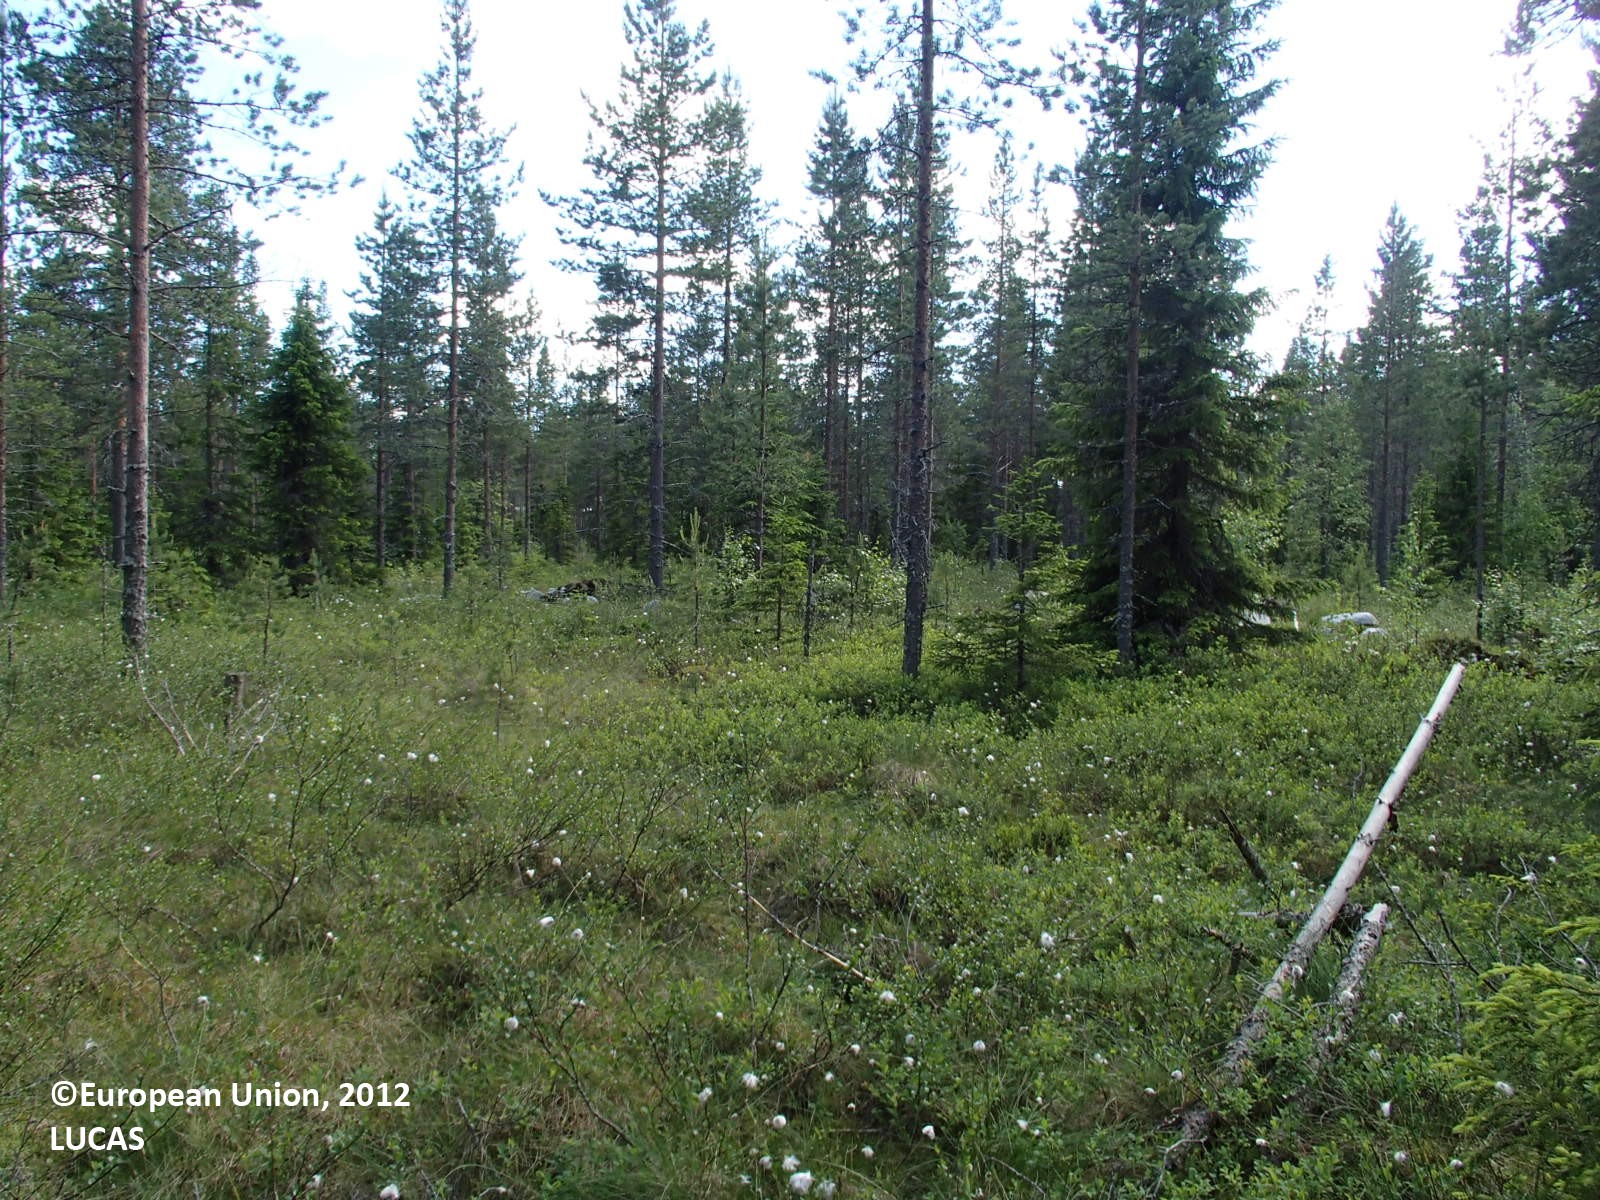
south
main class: Woodland
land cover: Pine dominated coniferous woodland
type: boreal forest
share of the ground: > 75 %
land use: Forestry
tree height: > 5 m
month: June
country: FI
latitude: 64.0165
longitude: 26.9284
